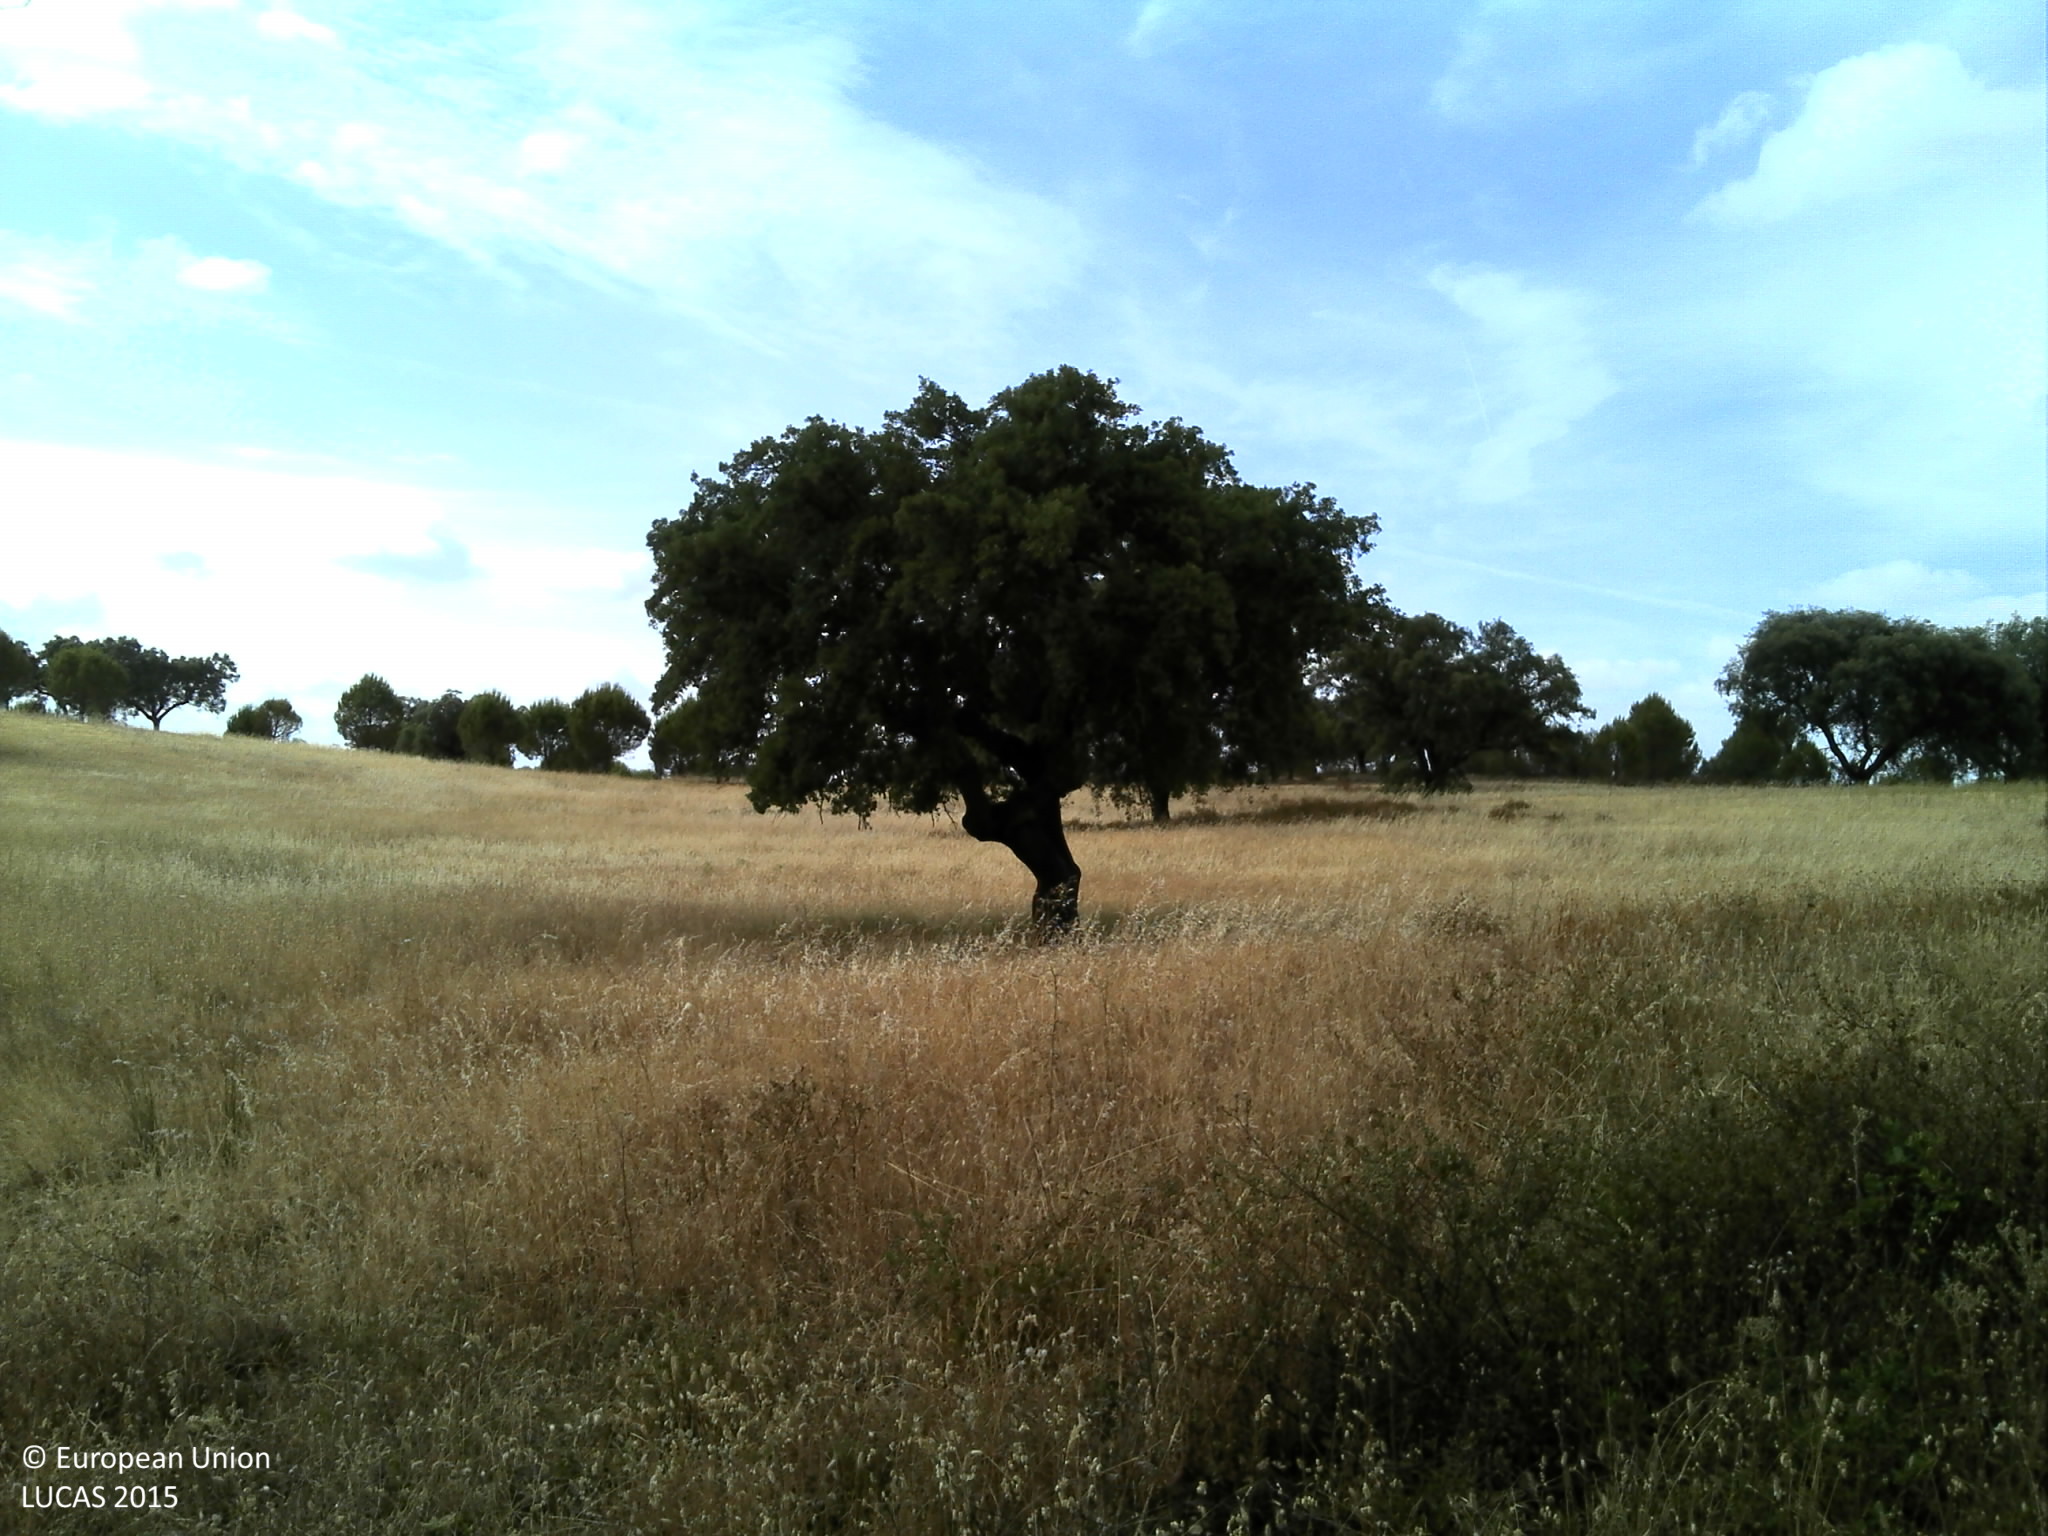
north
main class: Woodland
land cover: Broadleaved woodland
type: broadleaved evergreen forest
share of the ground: 25 - 50 %
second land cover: Grassland without tree/shrub cover
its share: 25 - 50 %
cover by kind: unconsolidated bare surface 35 %, herbaceous plants 30 %, broadleaved forest trees 25 %, shrubs 10 %
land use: Forestry
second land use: Agriculture (excluding fallow land and kitchen gardens)
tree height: > 5 m
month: June
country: PT
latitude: 38.3864
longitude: -7.7896
